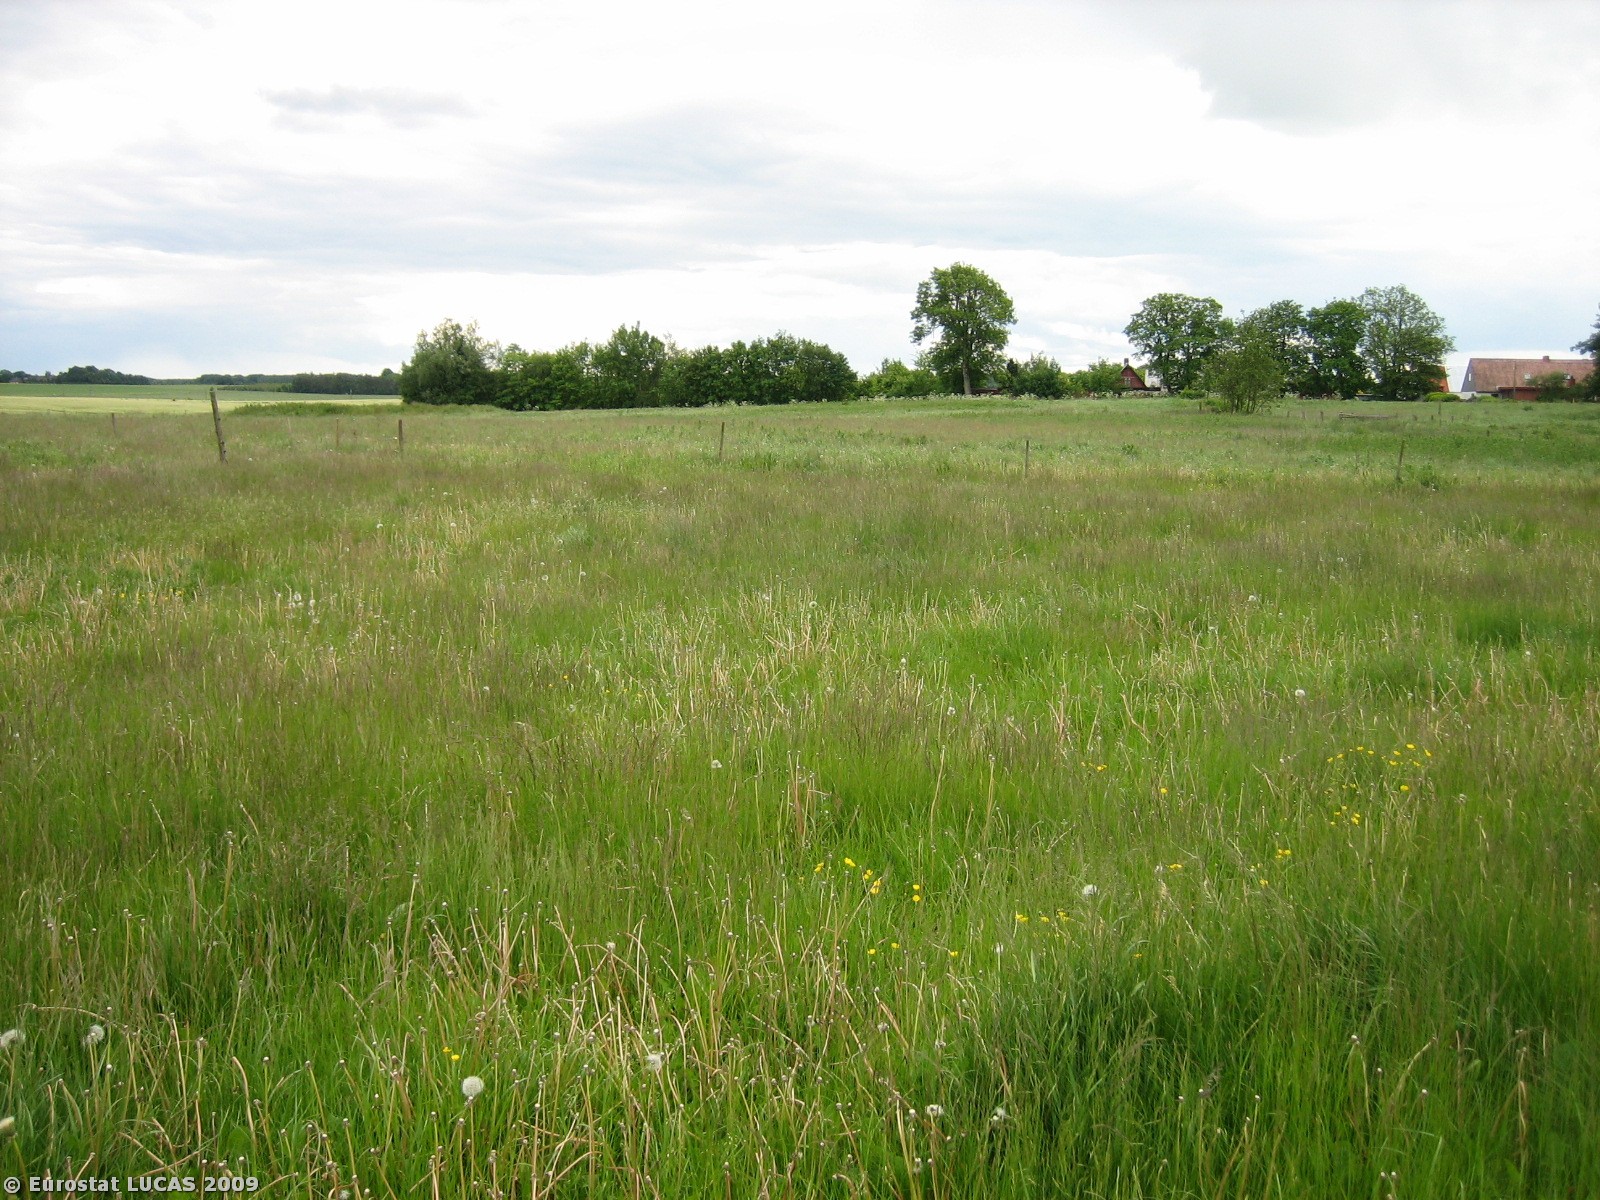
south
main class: Grassland
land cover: Grassland without tree/shrub cover
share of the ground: > 75 %
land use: Agriculture (excluding fallow land and kitchen gardens)
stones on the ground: < 10 %
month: June
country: DK
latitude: 56.2956
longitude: 9.9193
